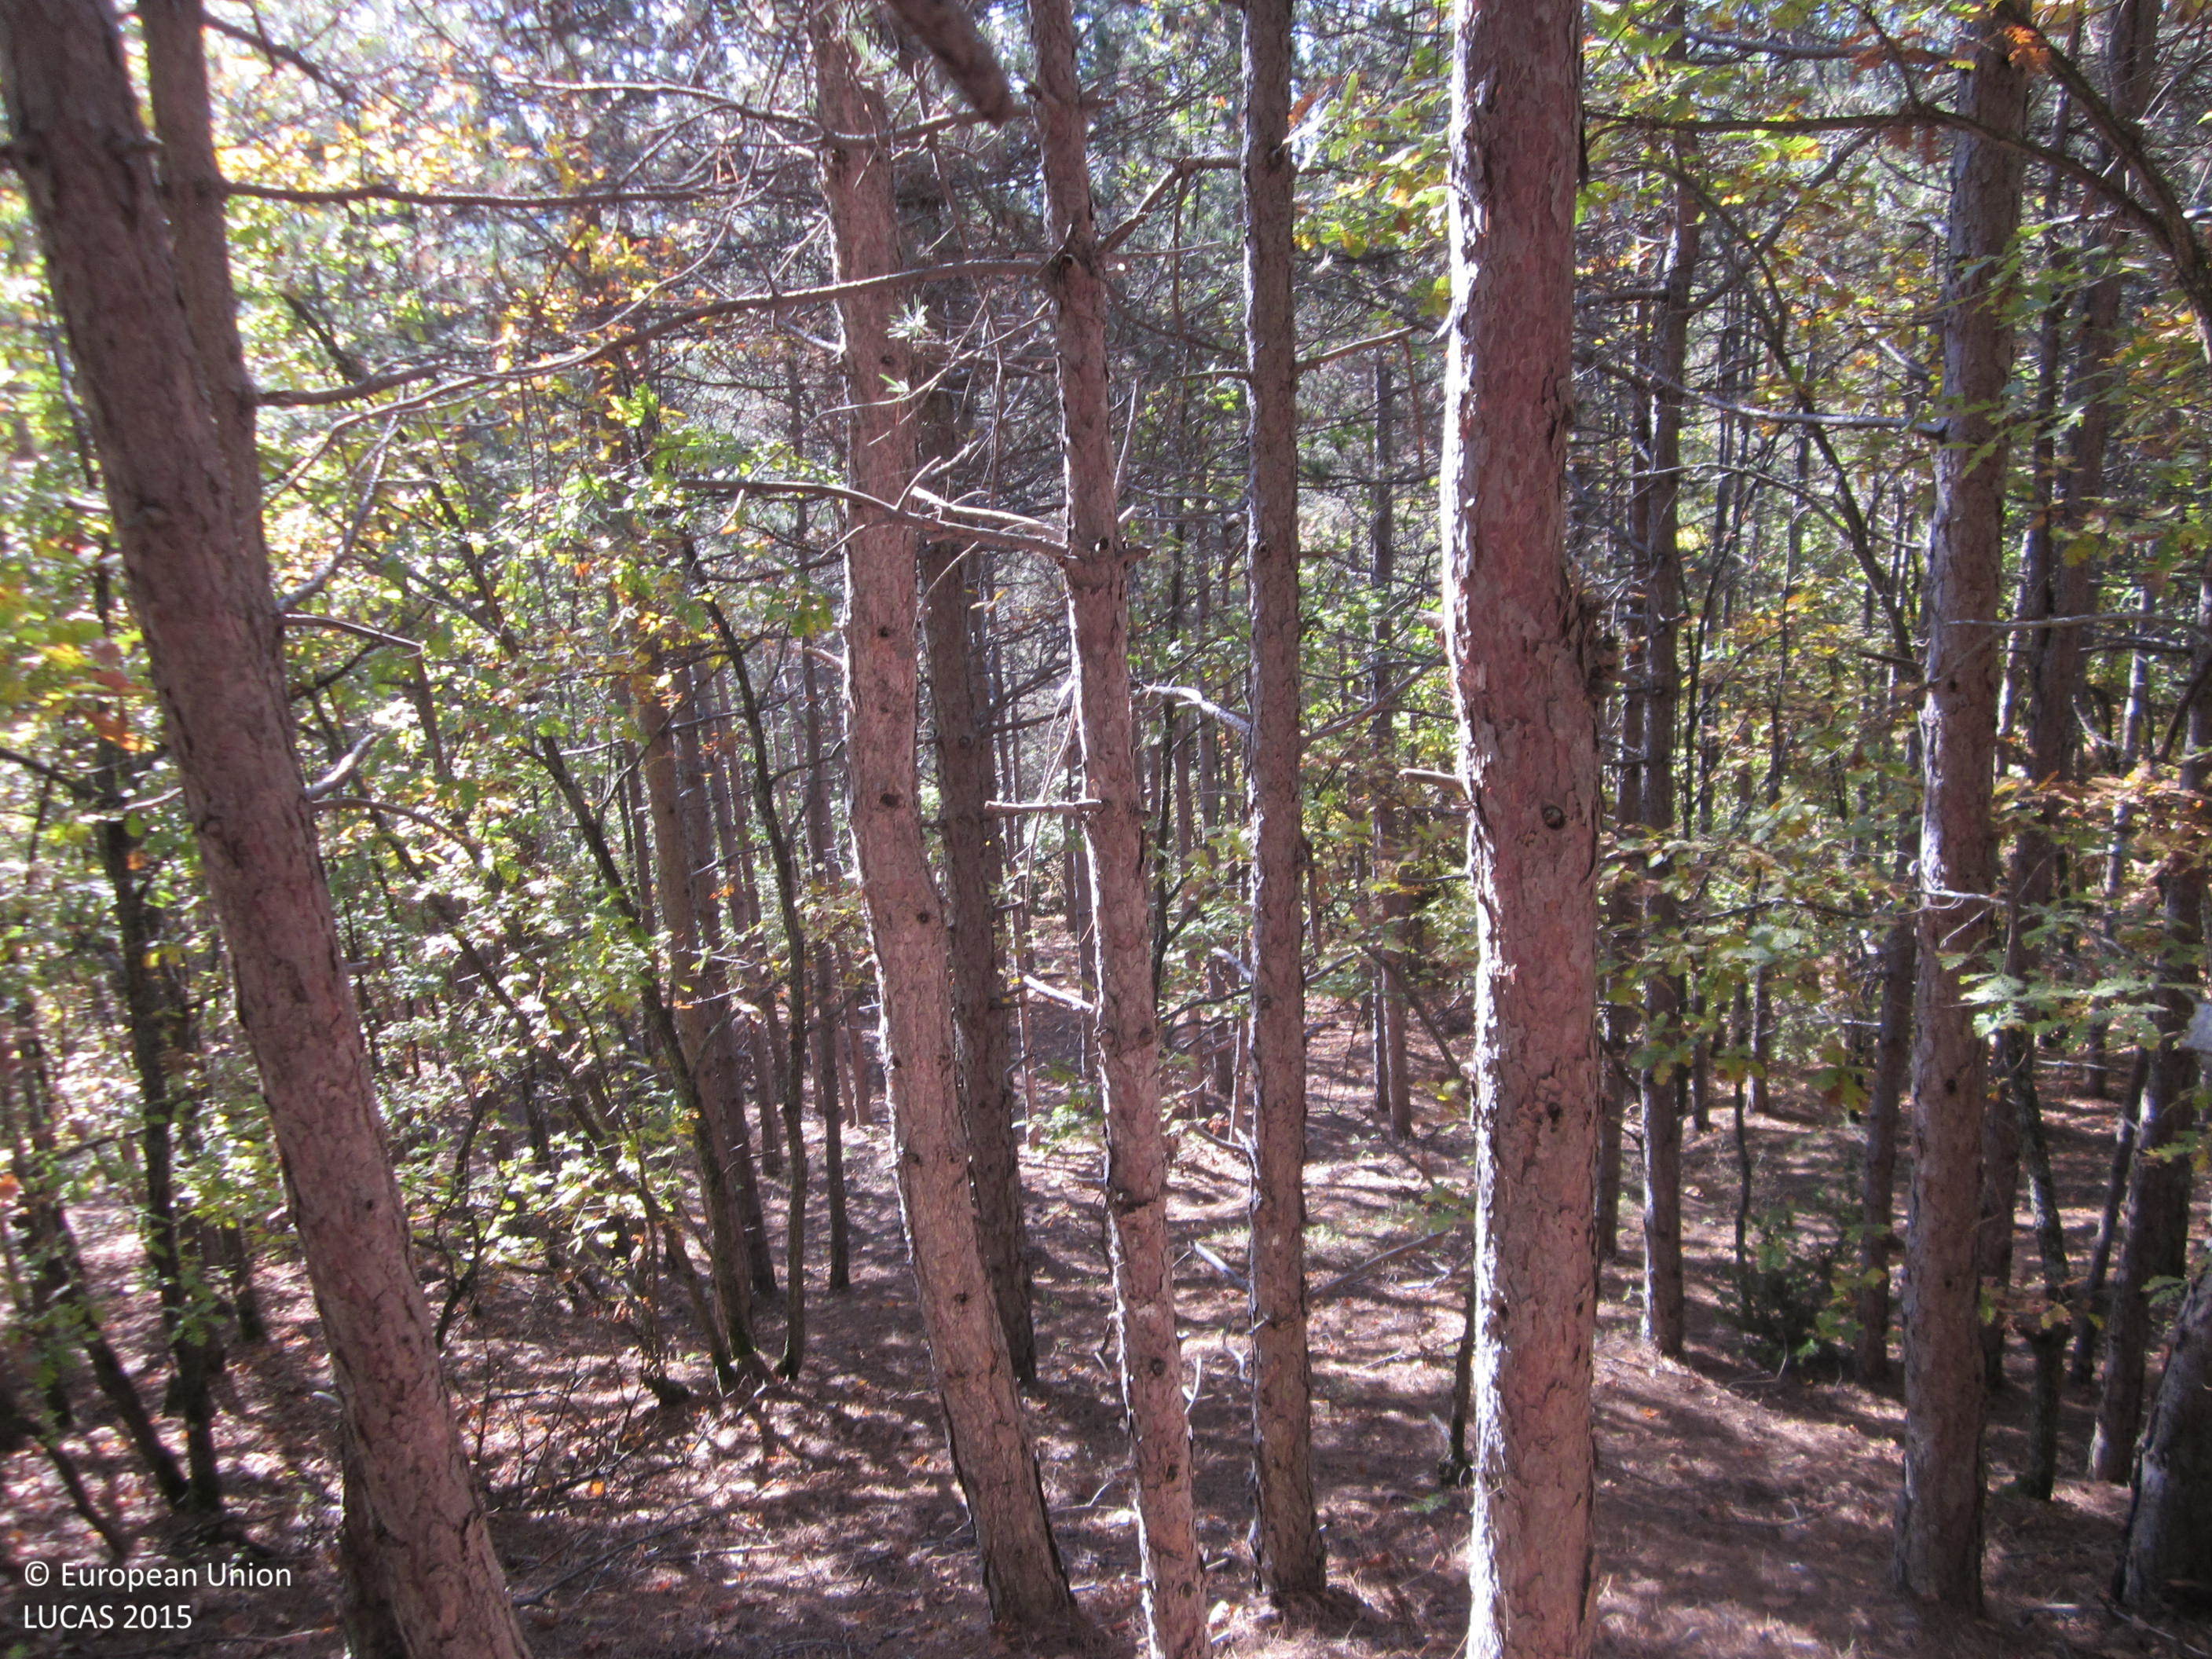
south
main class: Woodland
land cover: Pine dominated coniferous woodland
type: hemiboreal forest and nemoral coniferous forest and mixed broadleaved-coniferous forest
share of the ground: > 75 %
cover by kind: coniferous forest trees 70 %, unconsolidated bare surface 20 %, broadleaved forest trees 10 %
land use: Forestry
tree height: > 5 m
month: November
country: BG
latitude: 41.4664
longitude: 25.7593
